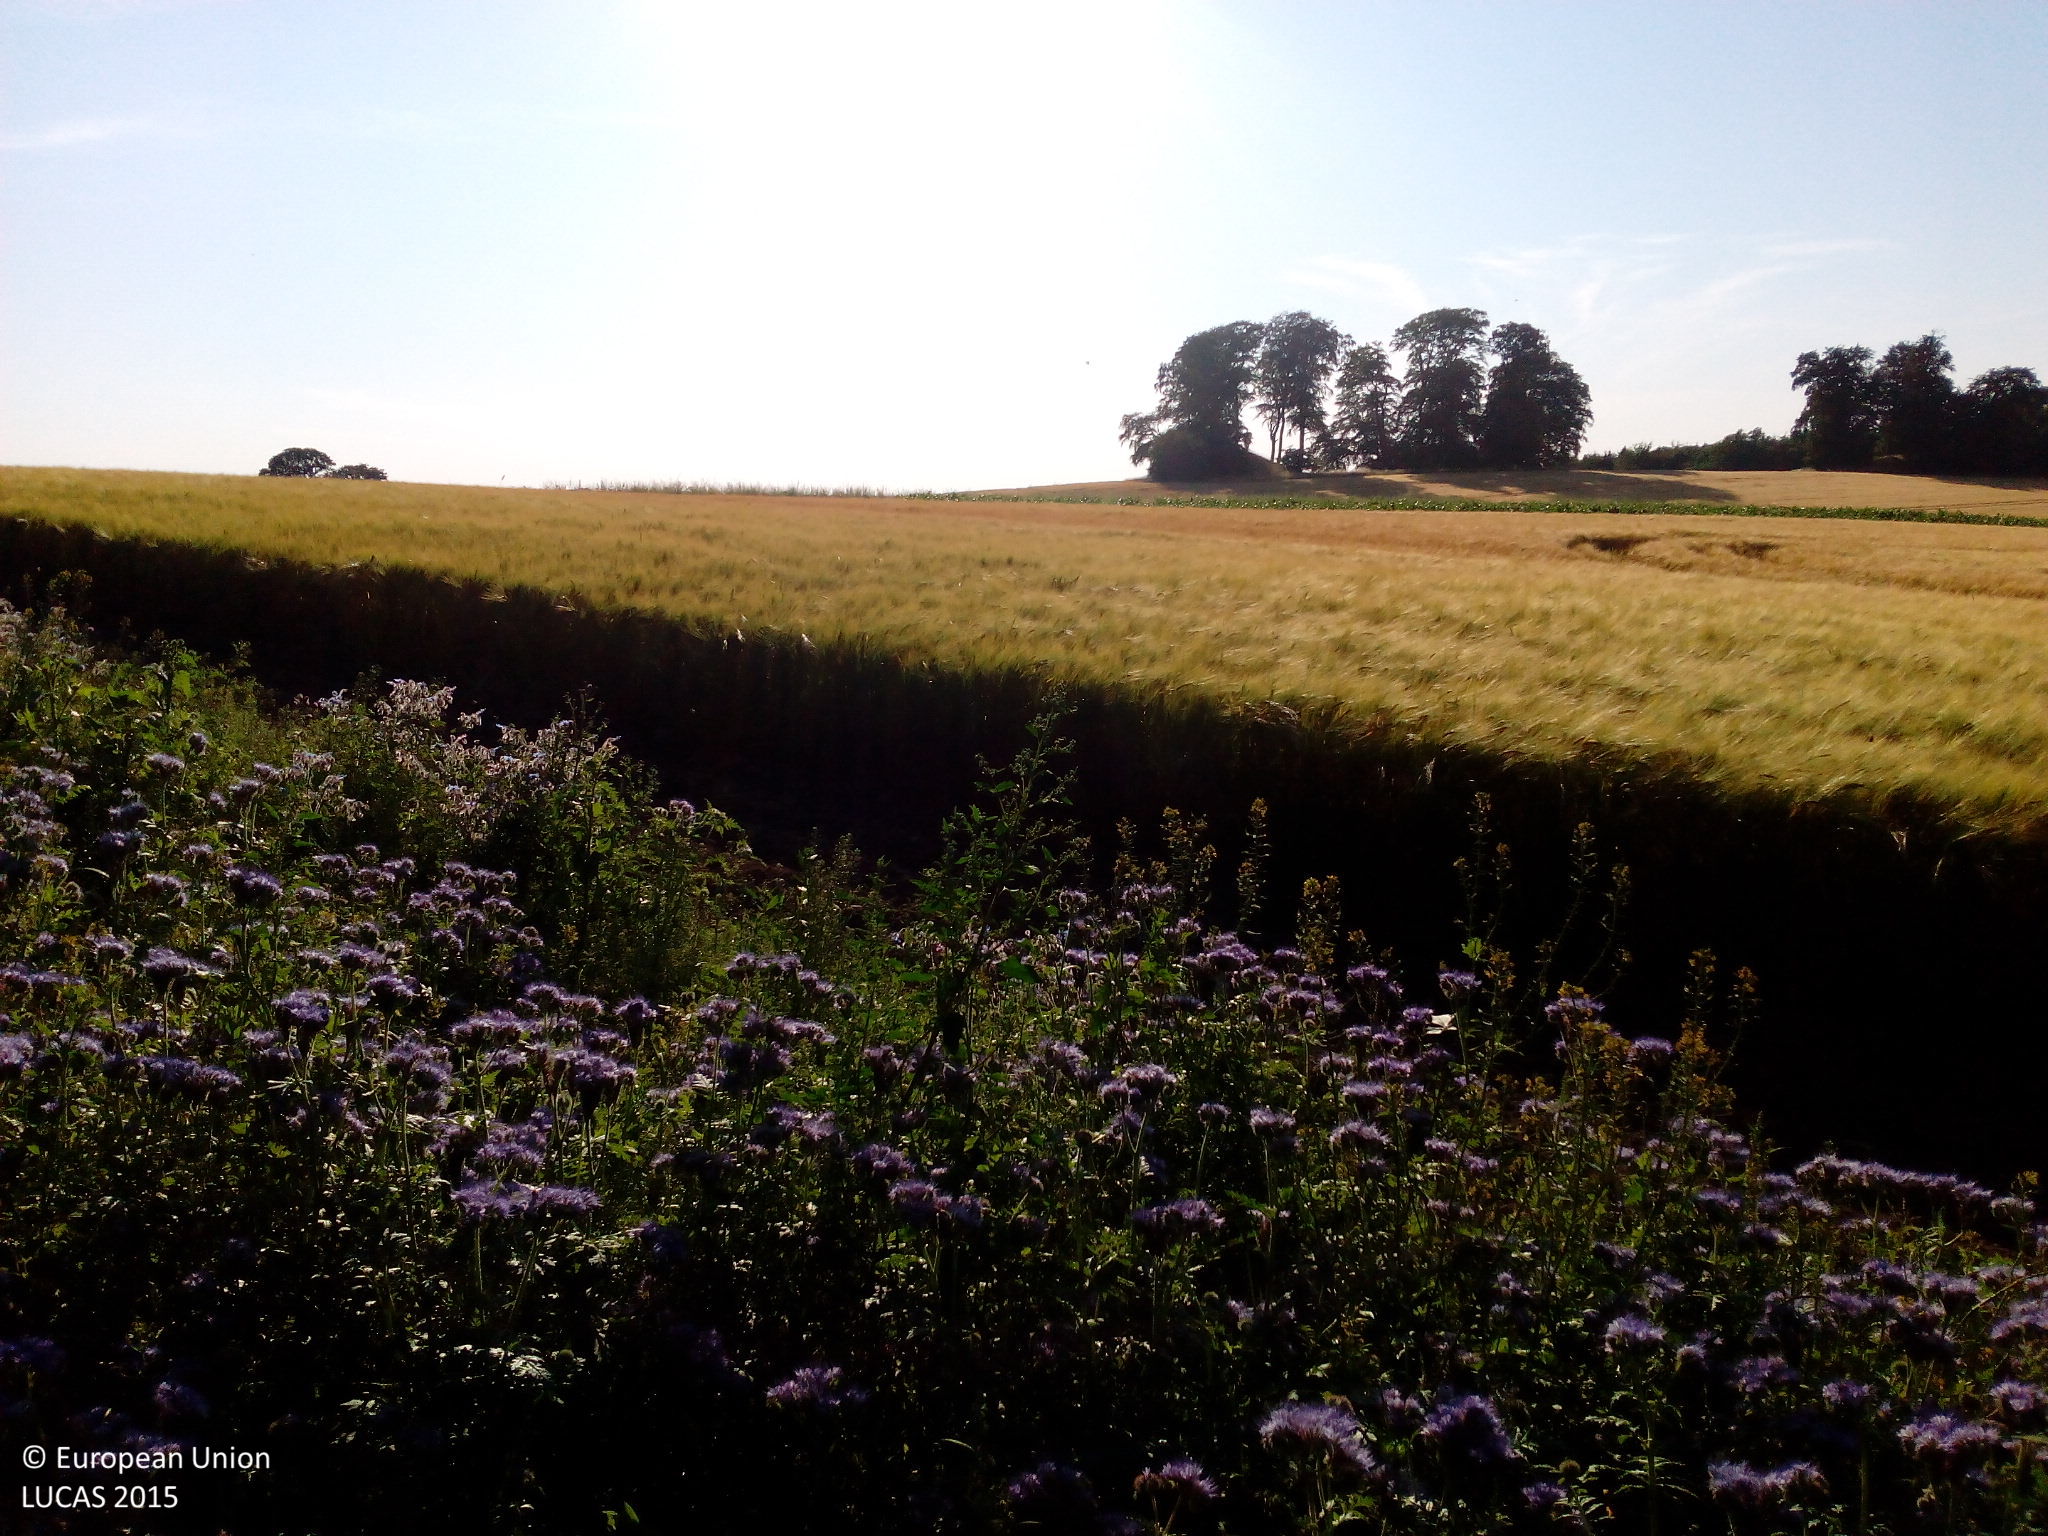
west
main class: Cropland
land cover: Lucerne
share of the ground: > 75 %
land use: Agriculture (excluding fallow land and kitchen gardens)
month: August
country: DK
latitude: 55.6709
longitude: 11.8586
